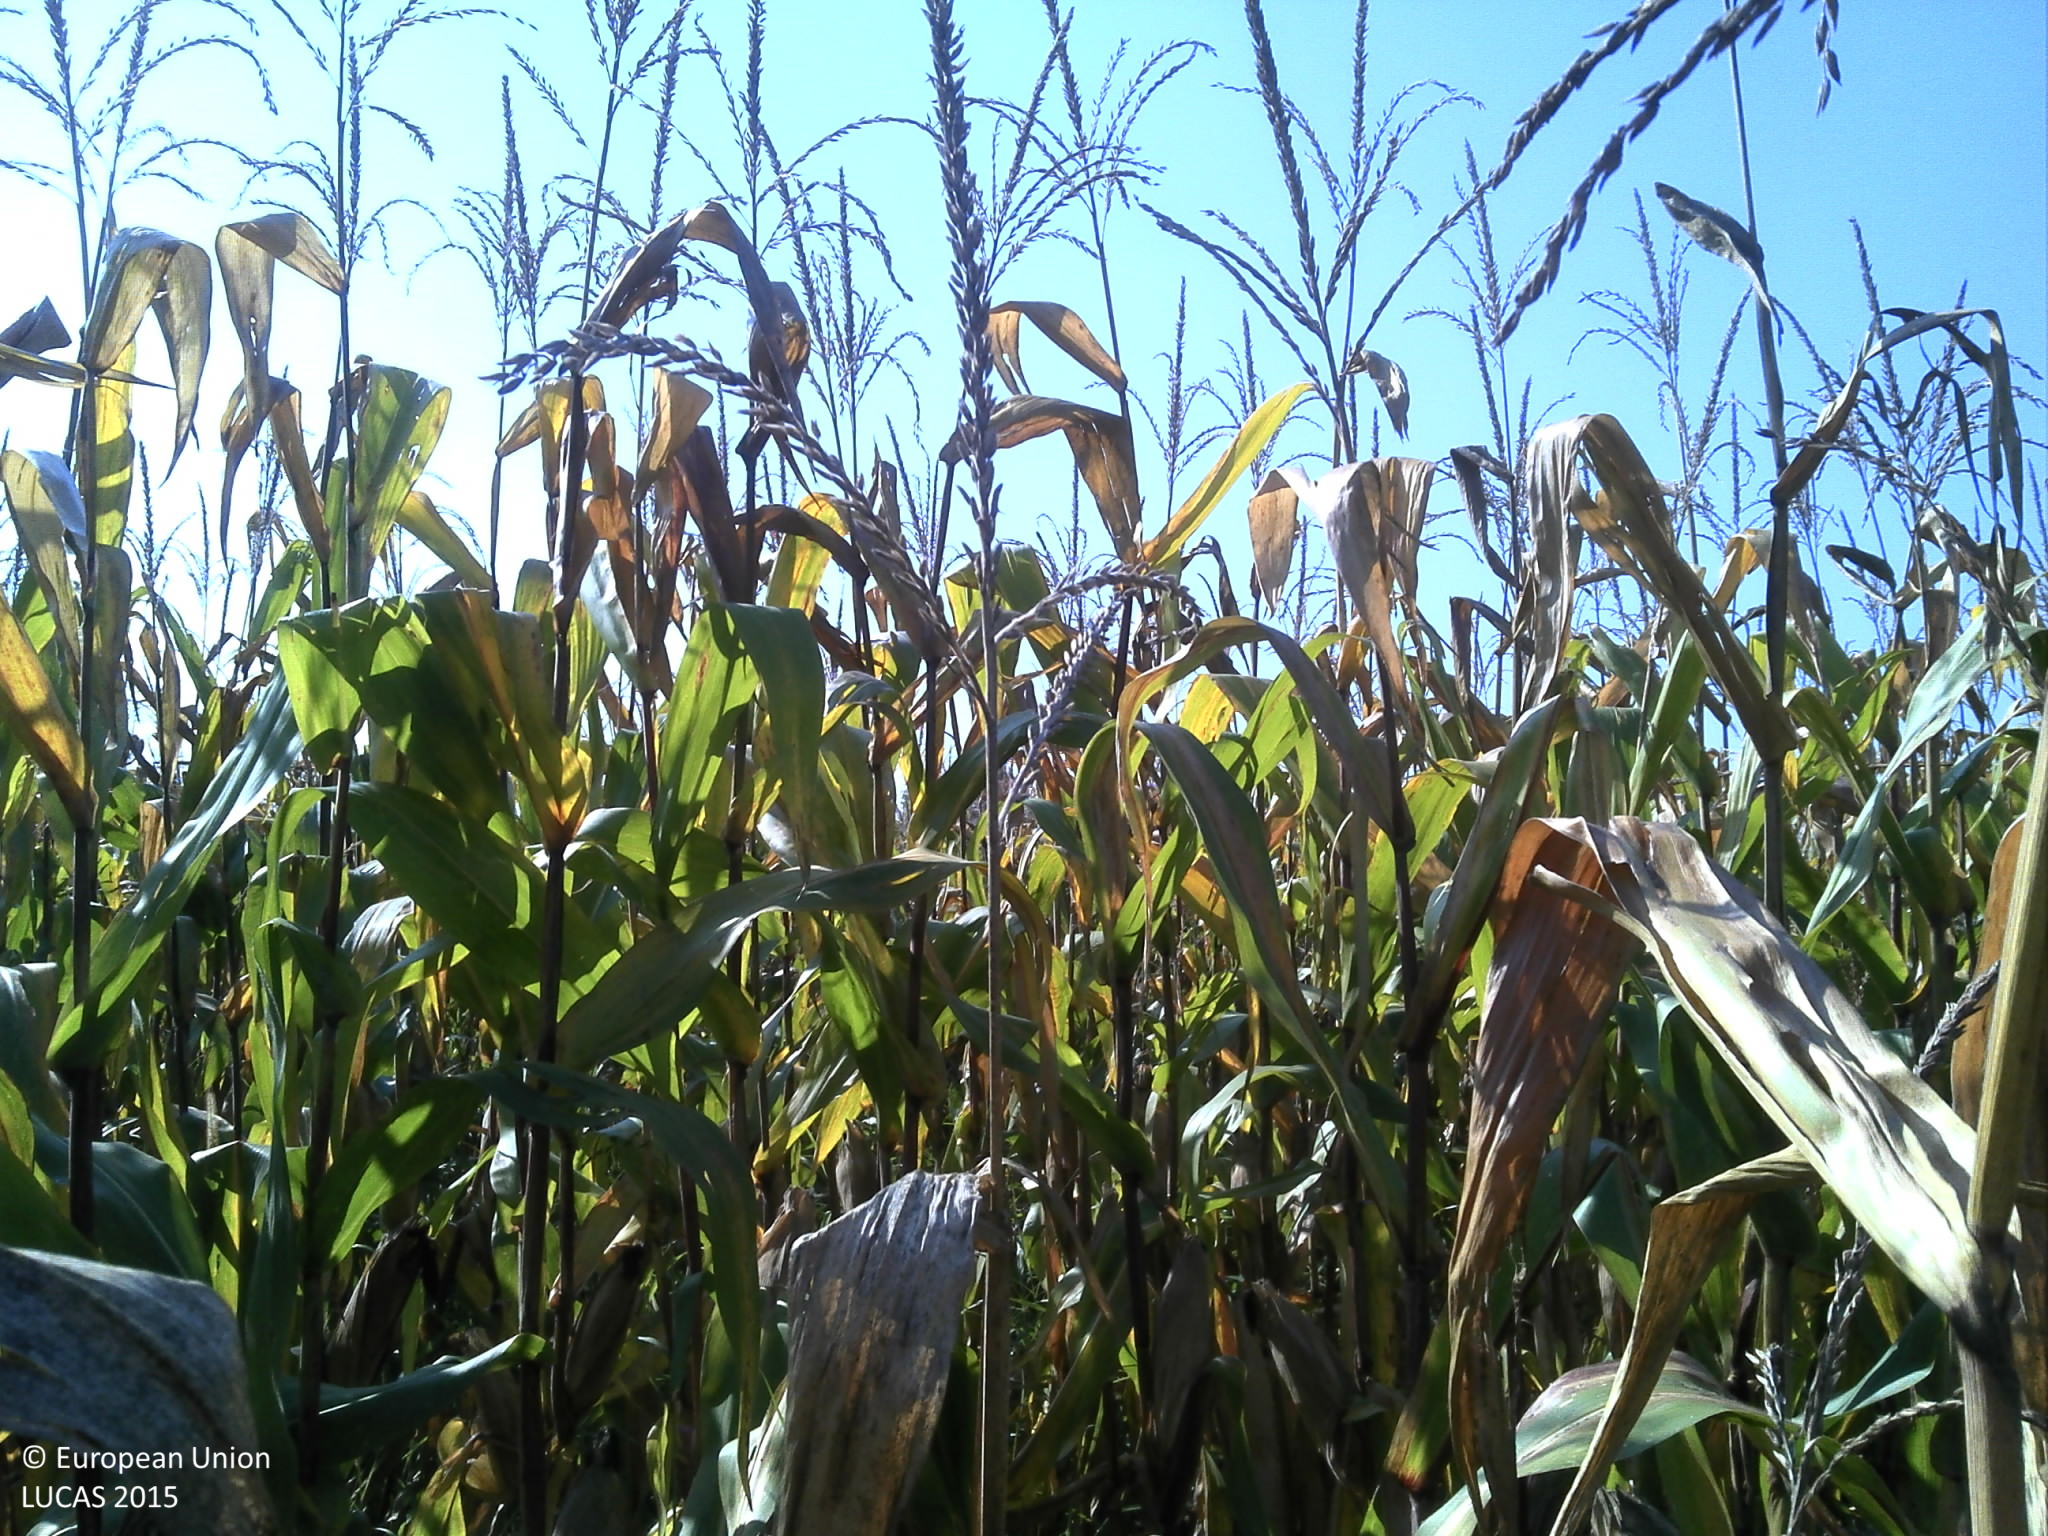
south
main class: Cropland
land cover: Maize
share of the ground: > 75 %
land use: Agriculture (excluding fallow land and kitchen gardens)
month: September
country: HR
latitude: 45.6012
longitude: 16.3700
